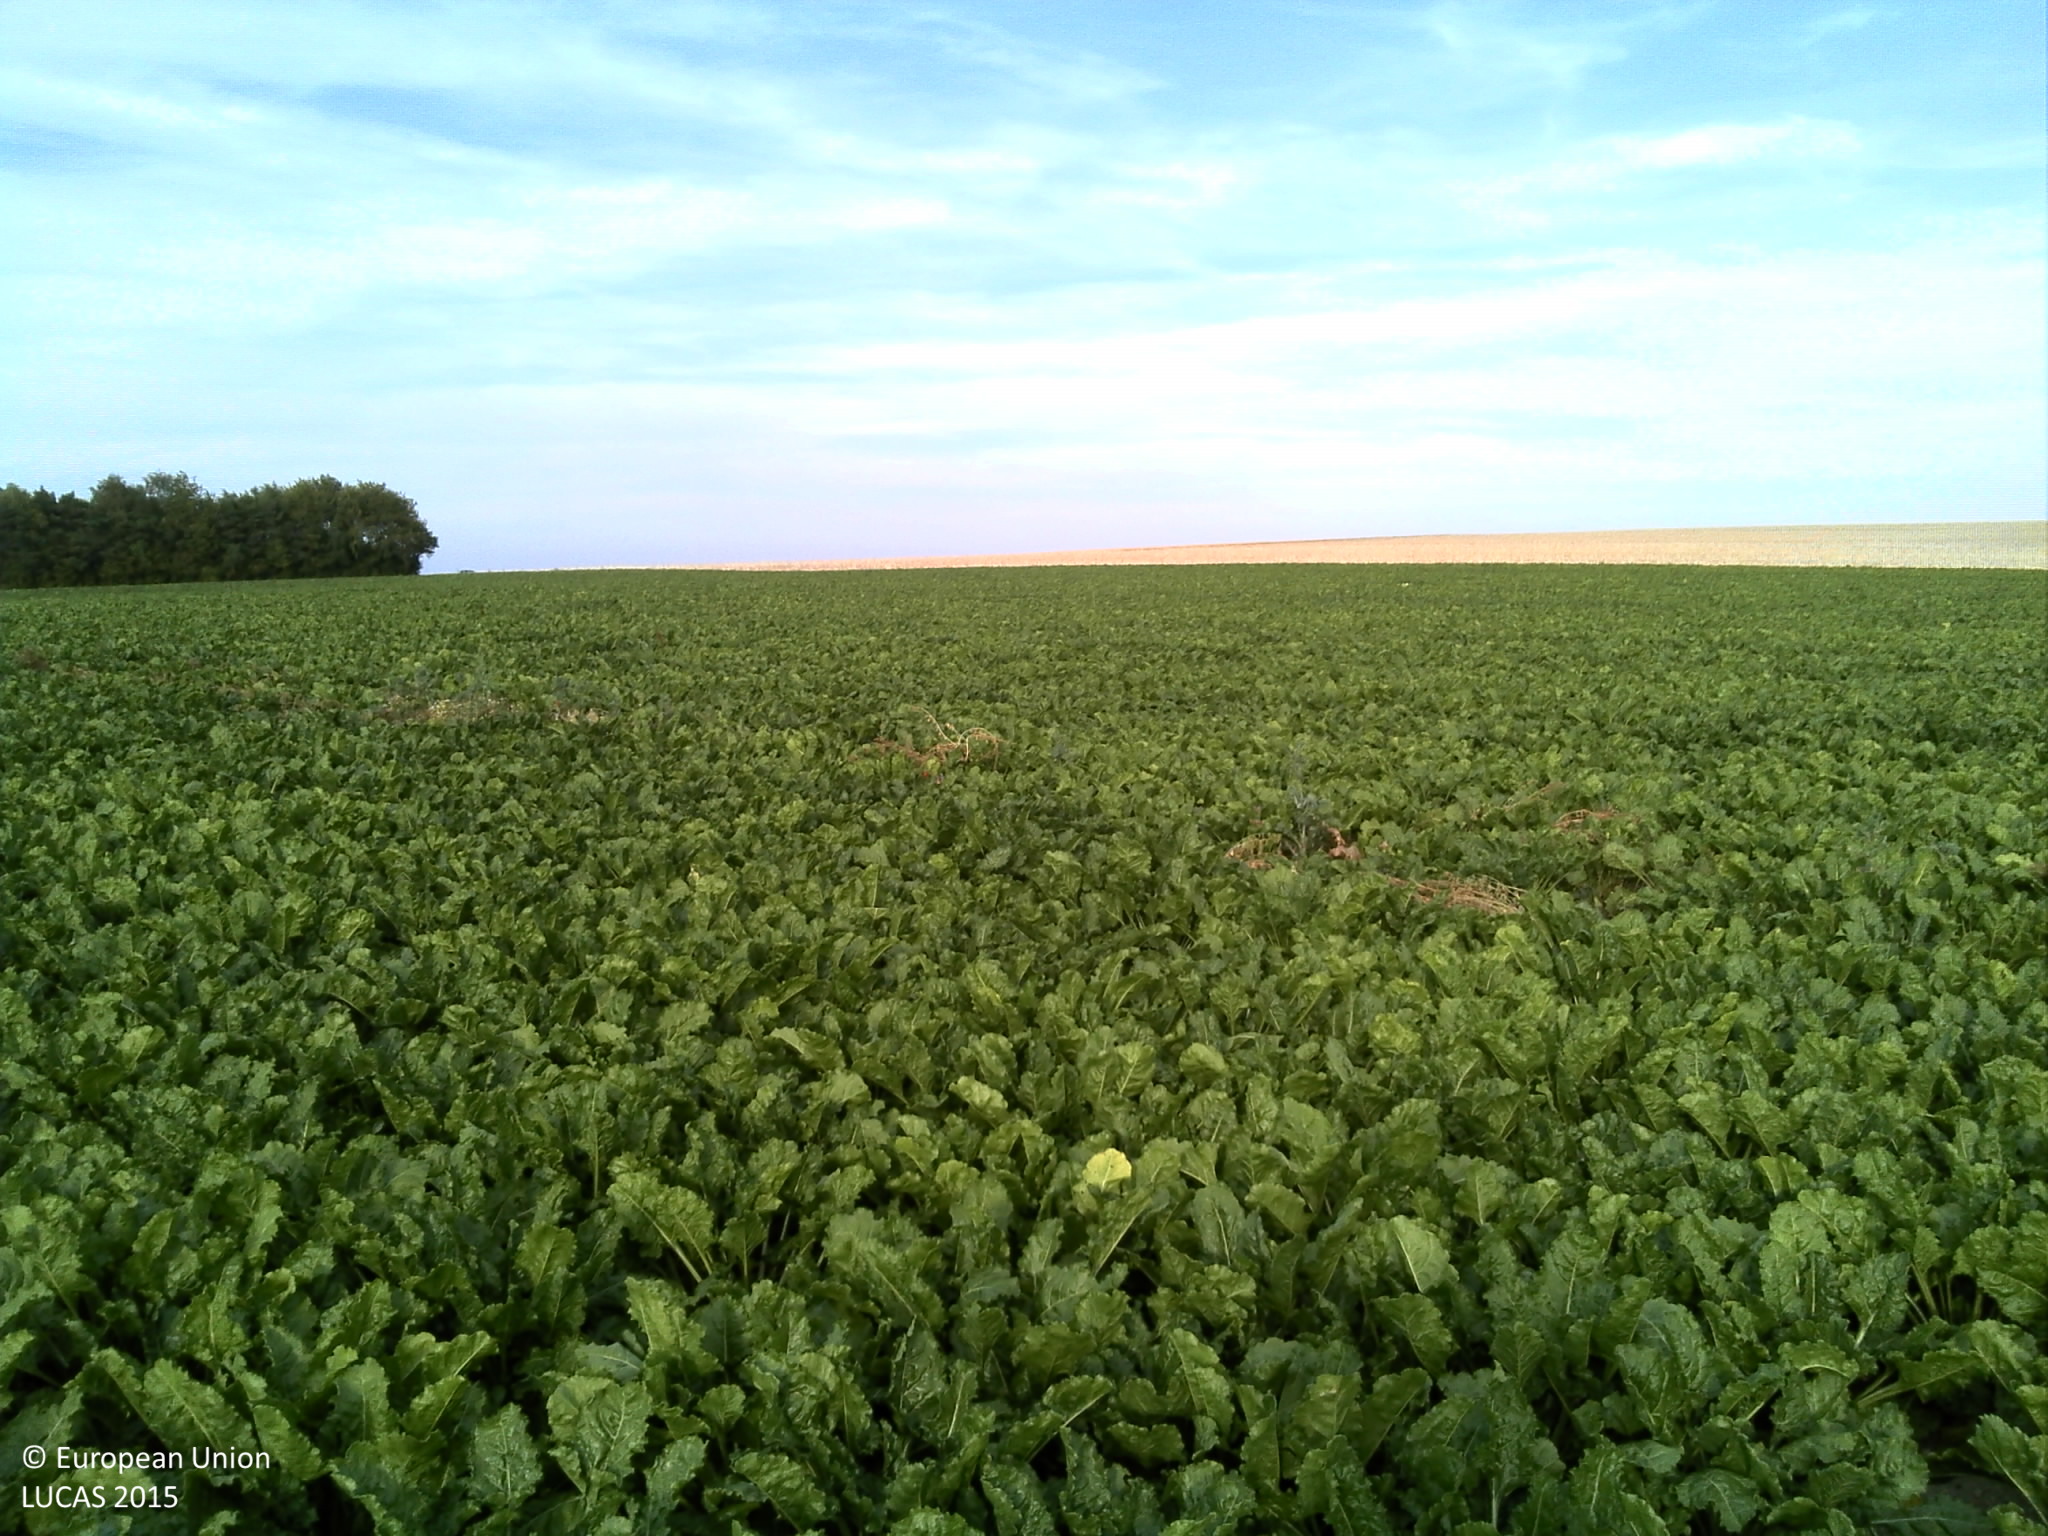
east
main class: Cropland
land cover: Sugar beet
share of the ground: 50 - 75 %
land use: Agriculture (excluding fallow land and kitchen gardens)
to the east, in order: Sugar beet; Rape and turnip rape
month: August
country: FR
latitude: 48.9621
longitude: 4.7114
